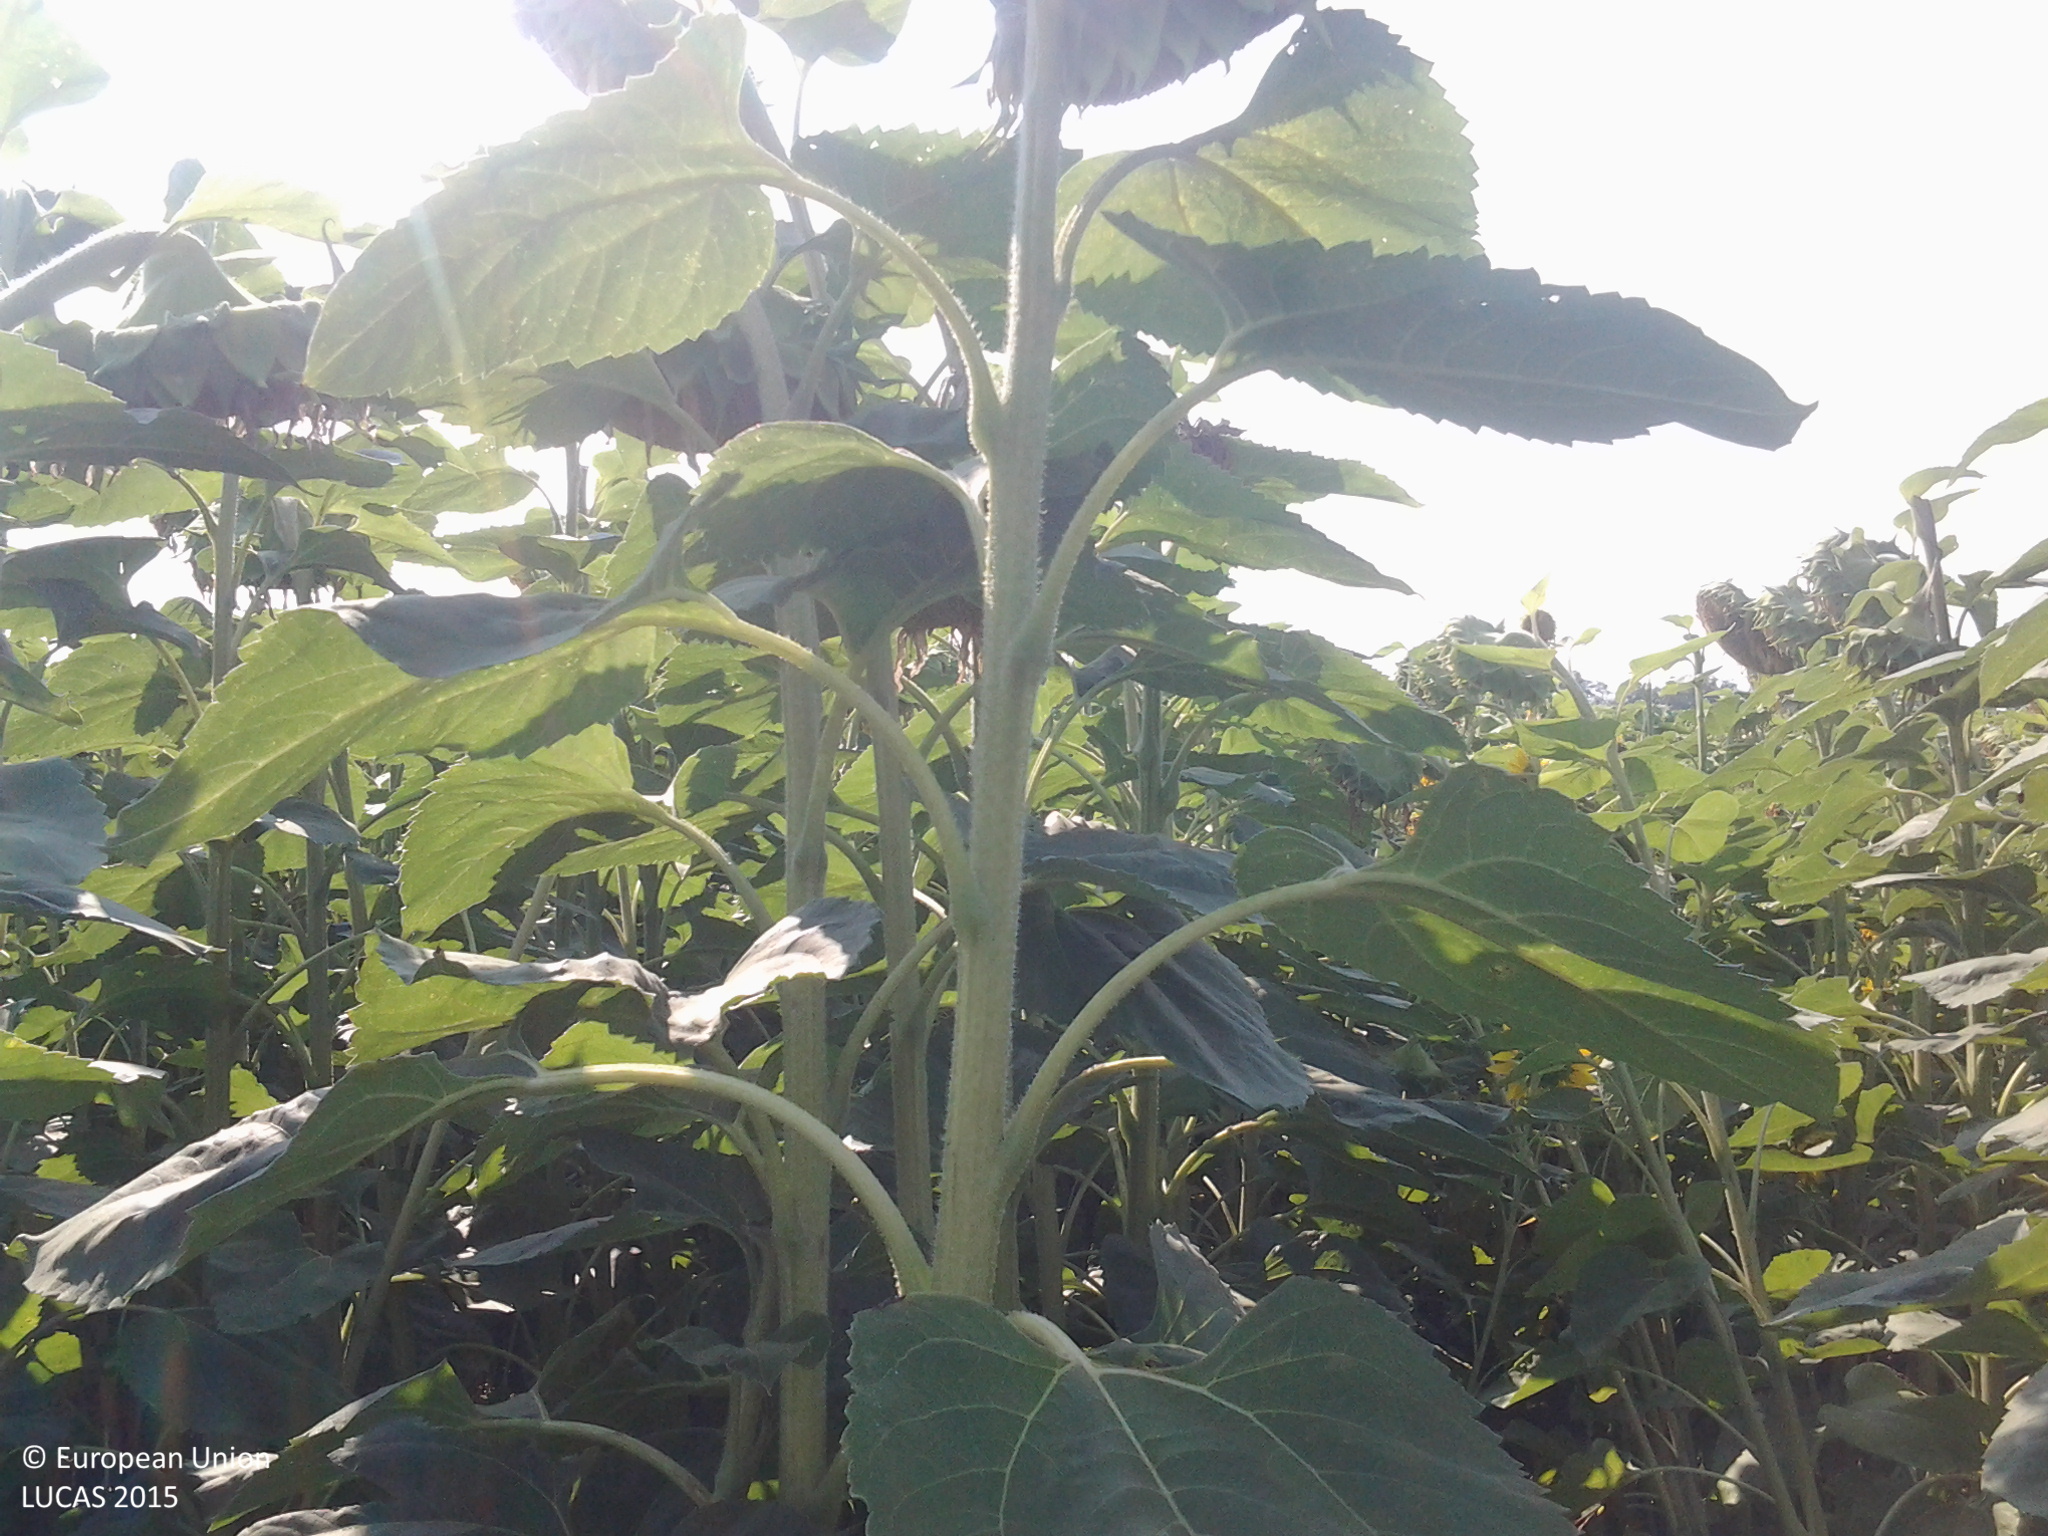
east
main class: Cropland
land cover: Sunflower
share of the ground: > 75 %
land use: Agriculture (excluding fallow land and kitchen gardens)
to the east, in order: Sunflower; Grassland without tree/shrub cover; Sunflower
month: July
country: HU
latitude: 46.8188
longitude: 19.0459
